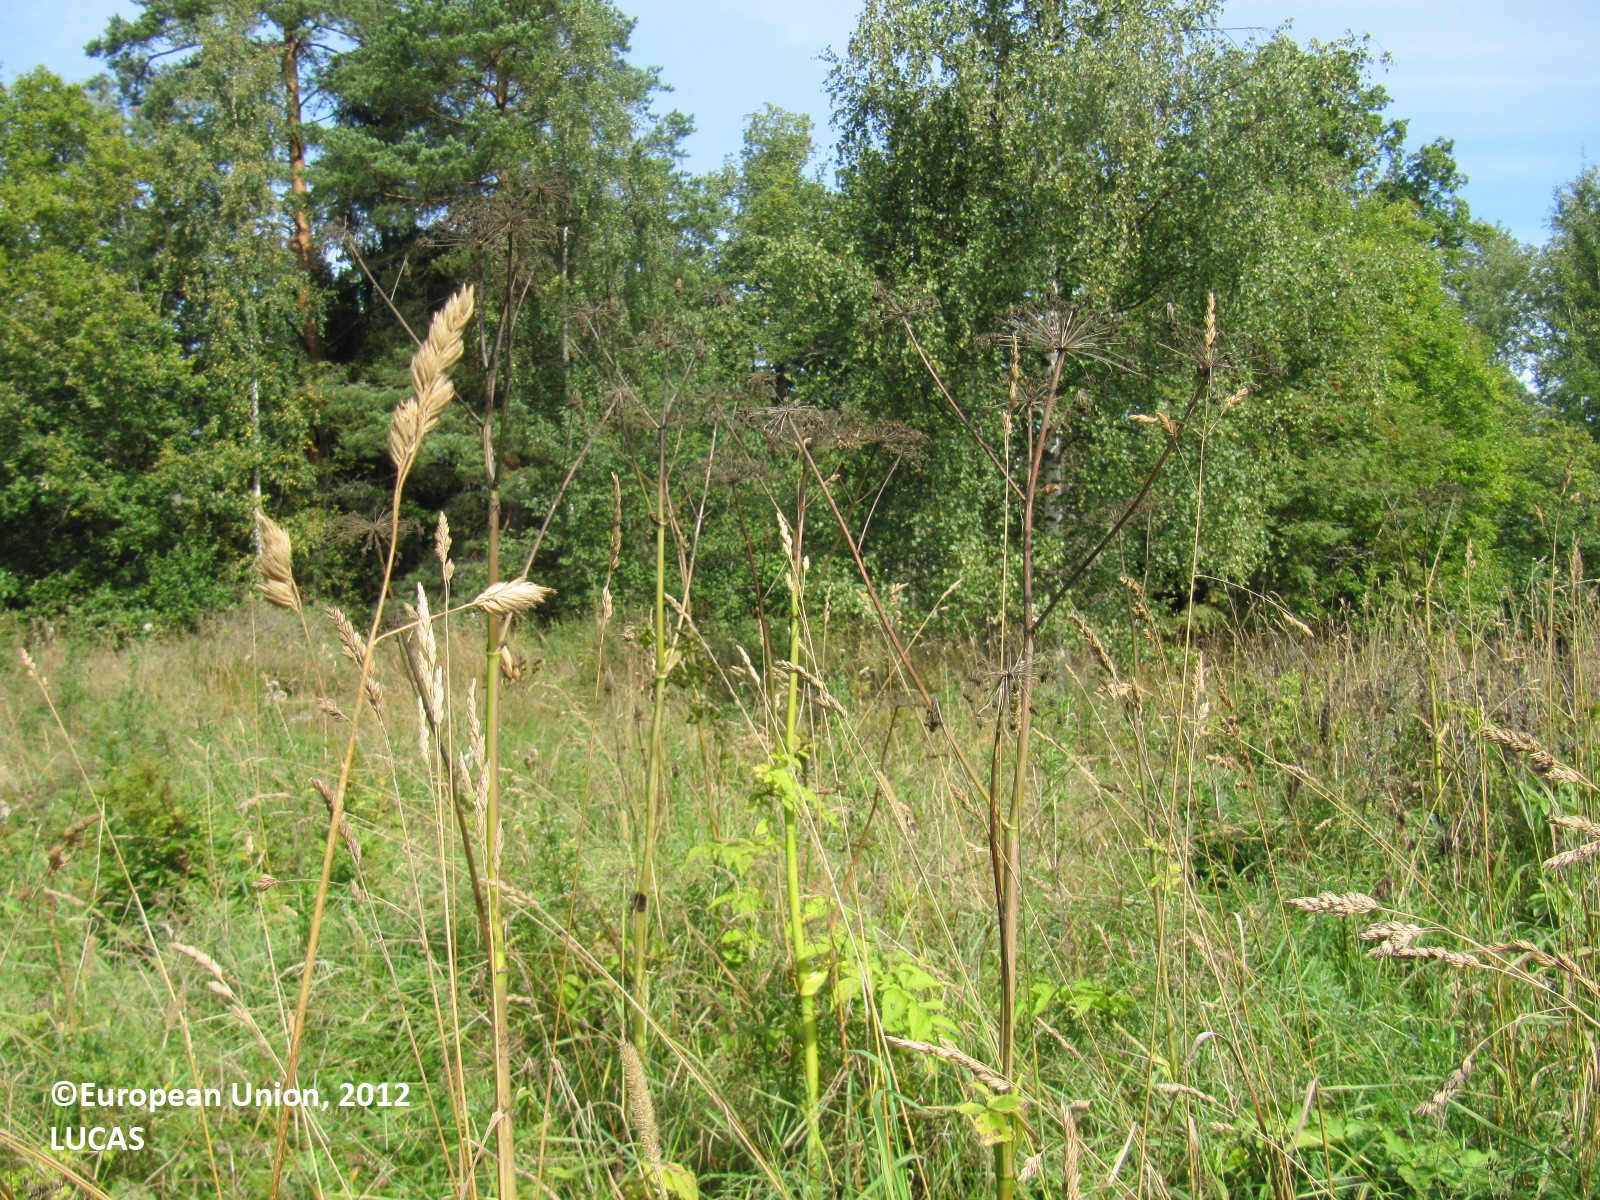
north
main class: Grassland
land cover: Spontaneously vegetated surfaces
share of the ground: > 75 %
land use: Fallow land
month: August
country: FI
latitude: 60.2237
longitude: 23.8693
